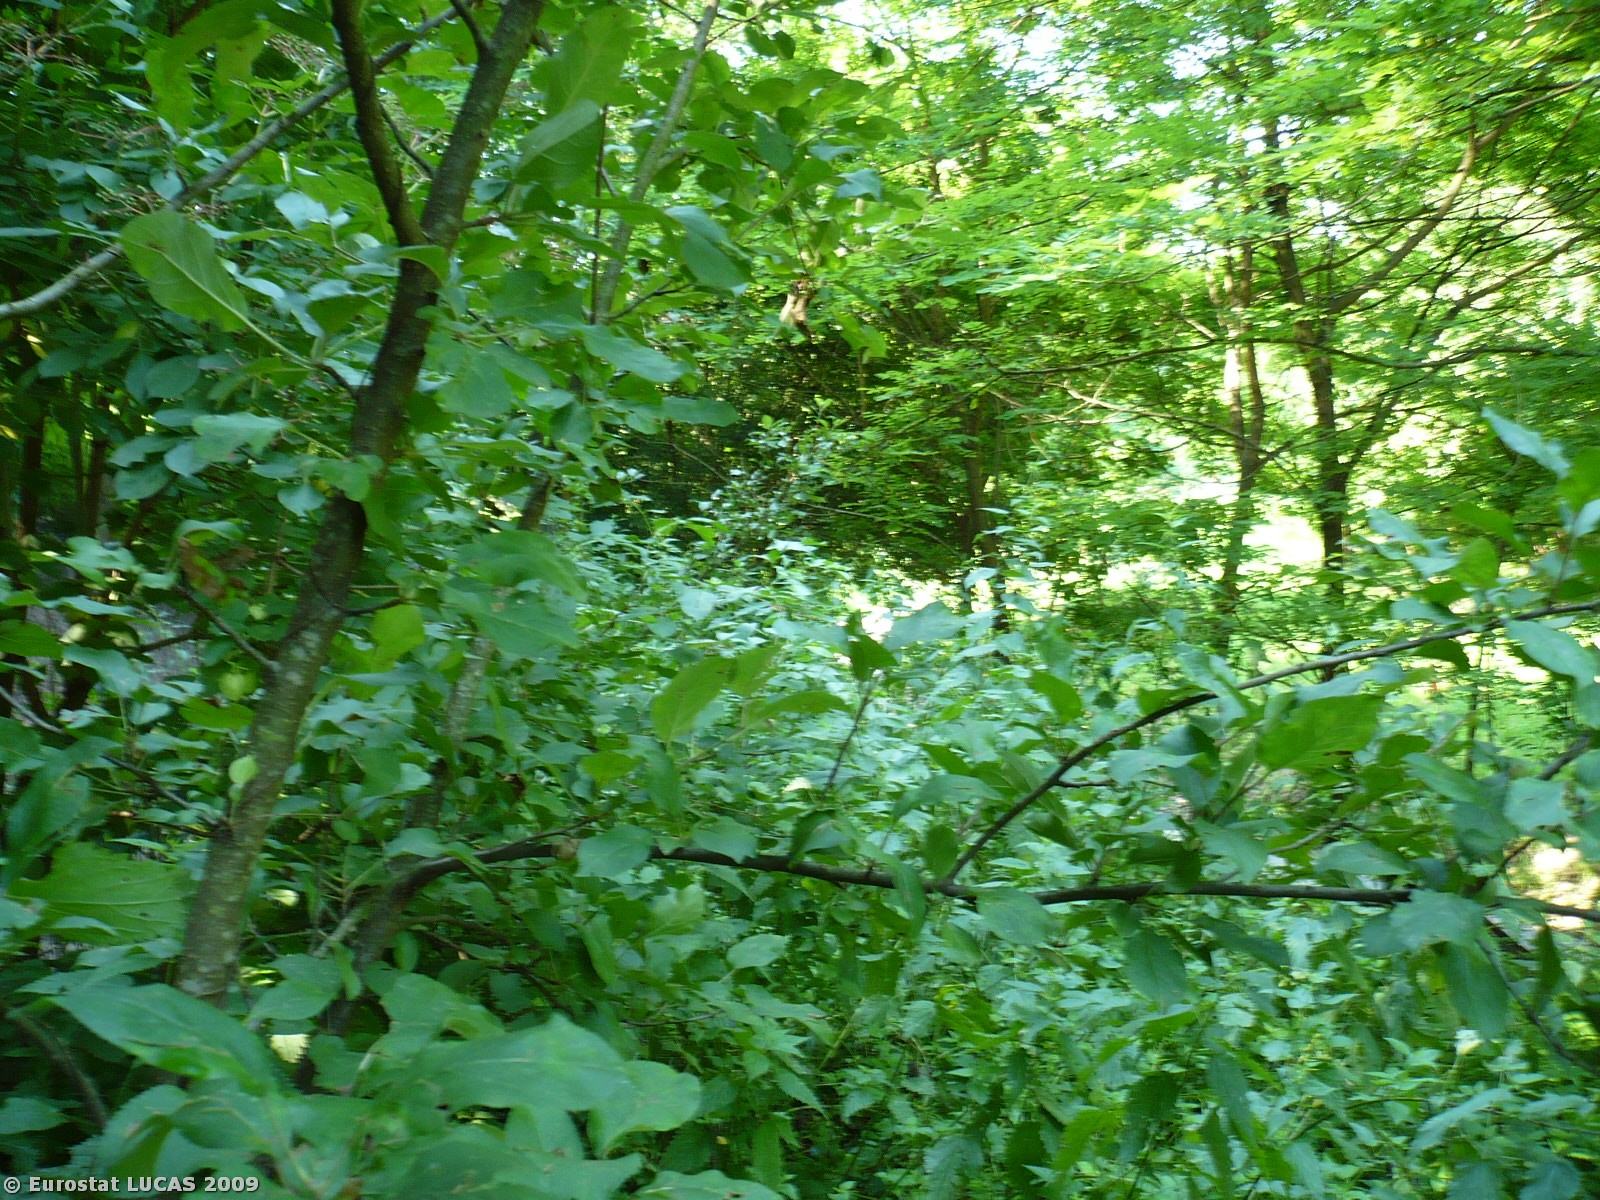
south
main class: Woodland
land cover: Broadleaved woodland
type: mesophytic deciduous forest
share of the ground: > 75 %
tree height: > 5 m
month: July
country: SI
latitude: 46.5503
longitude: 16.5094
